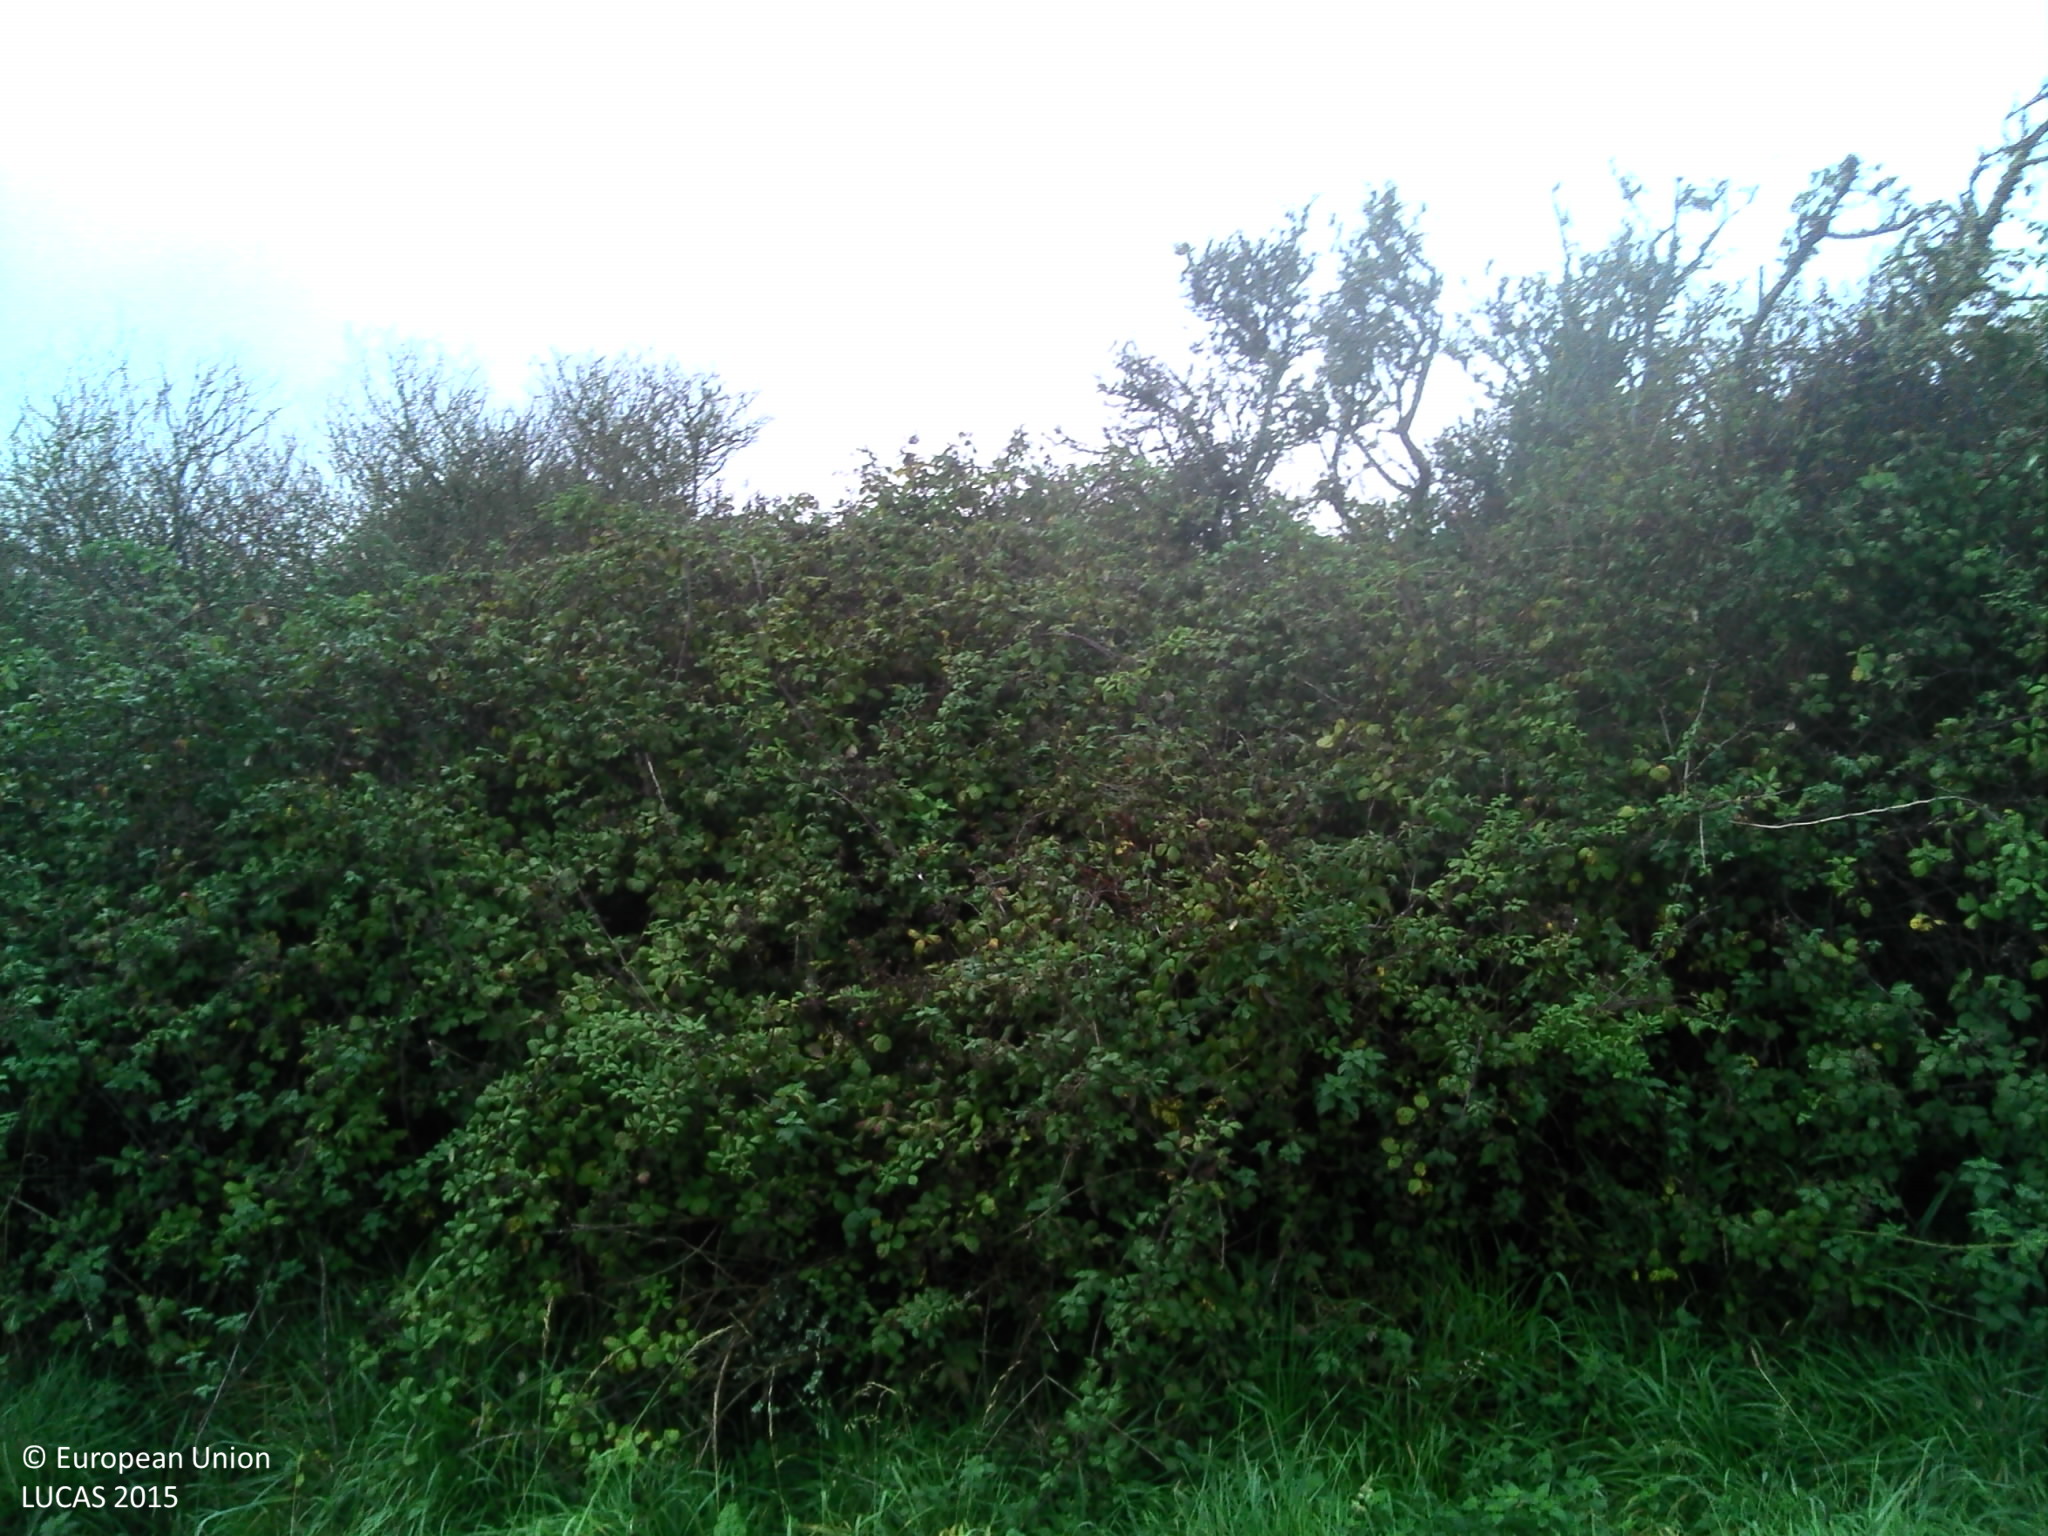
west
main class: Shrubland
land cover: Shrubland with sparse tree cover
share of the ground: > 75 %
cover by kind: shrubs 95 %, broadleaved forest trees 5 %
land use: Semi-natural and natural areas not in use
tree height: < 5 m
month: November
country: FR
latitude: 47.3075
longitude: -3.1211
